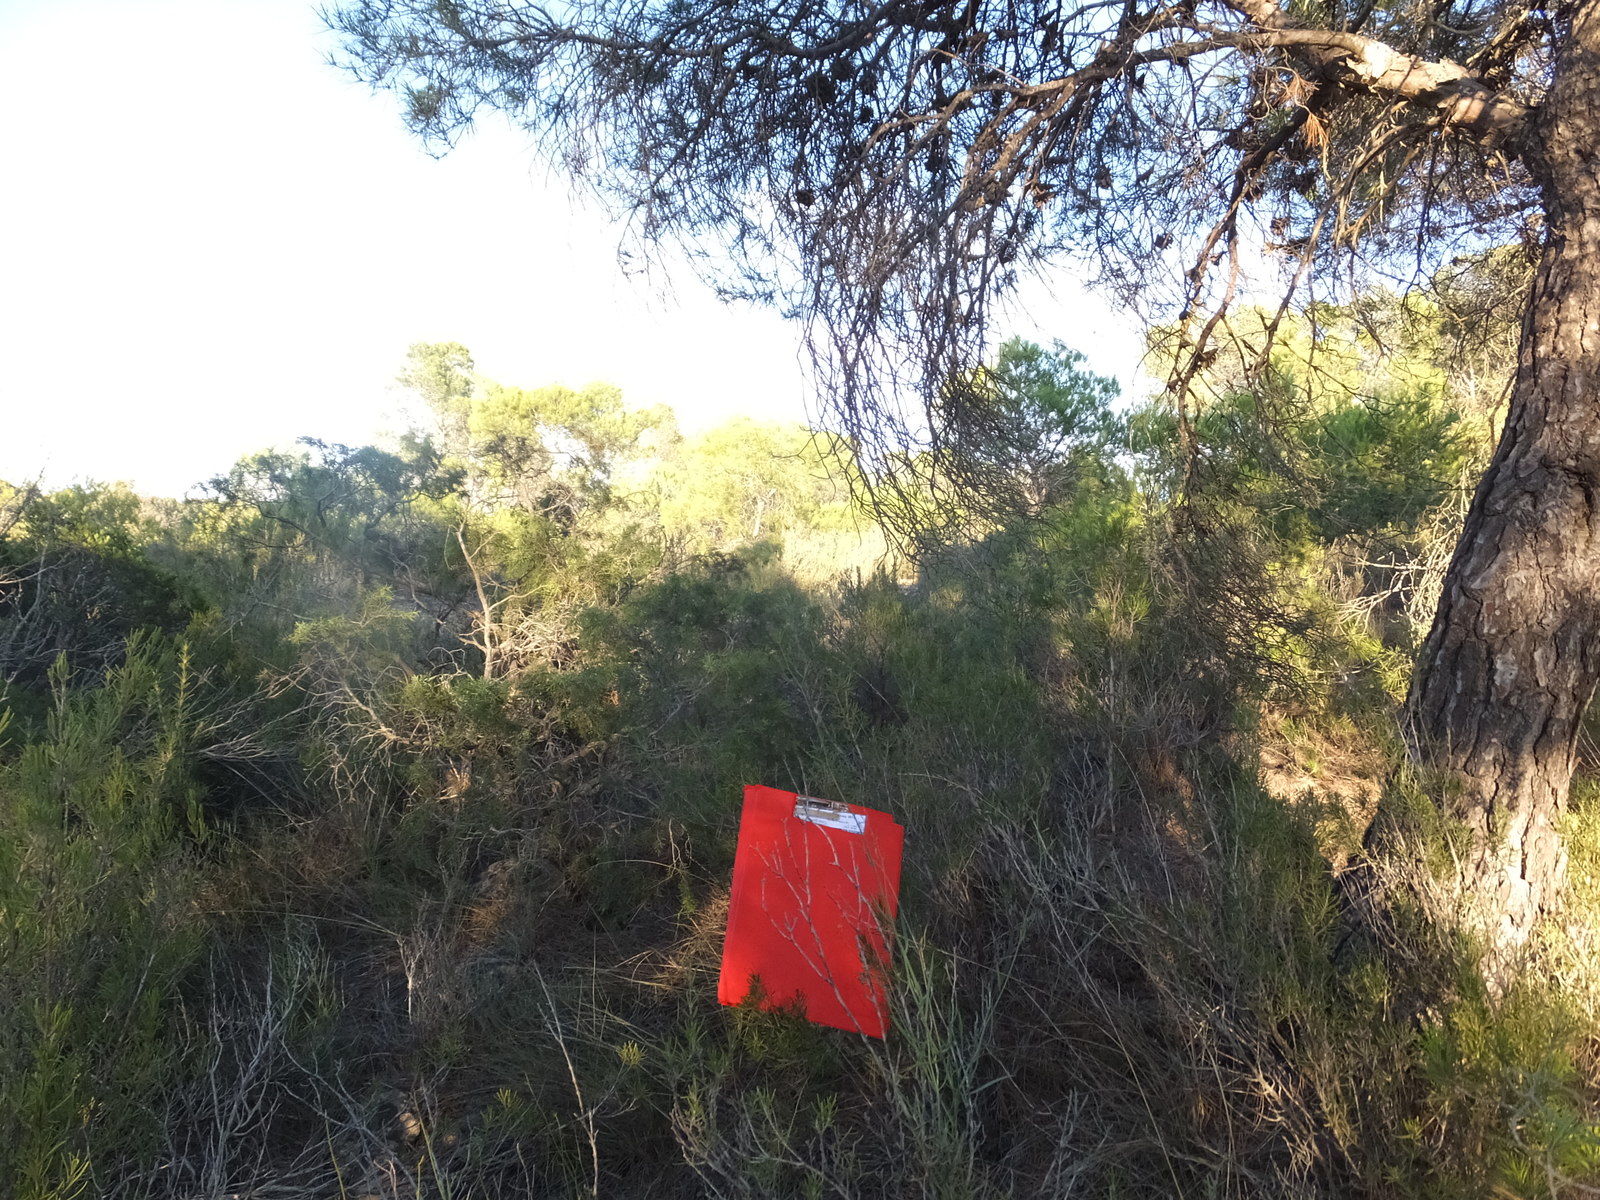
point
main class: Woodland
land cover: Pine dominated mixed woodland
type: coniferous forest of the mediterranean region
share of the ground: 50 - 75 %
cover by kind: coniferous forest trees 60 %, broadleaved forest trees 20 %, shrubs 20 %
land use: Forestry
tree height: > 5 m
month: August
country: ES
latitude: 41.2064
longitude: 0.1260
